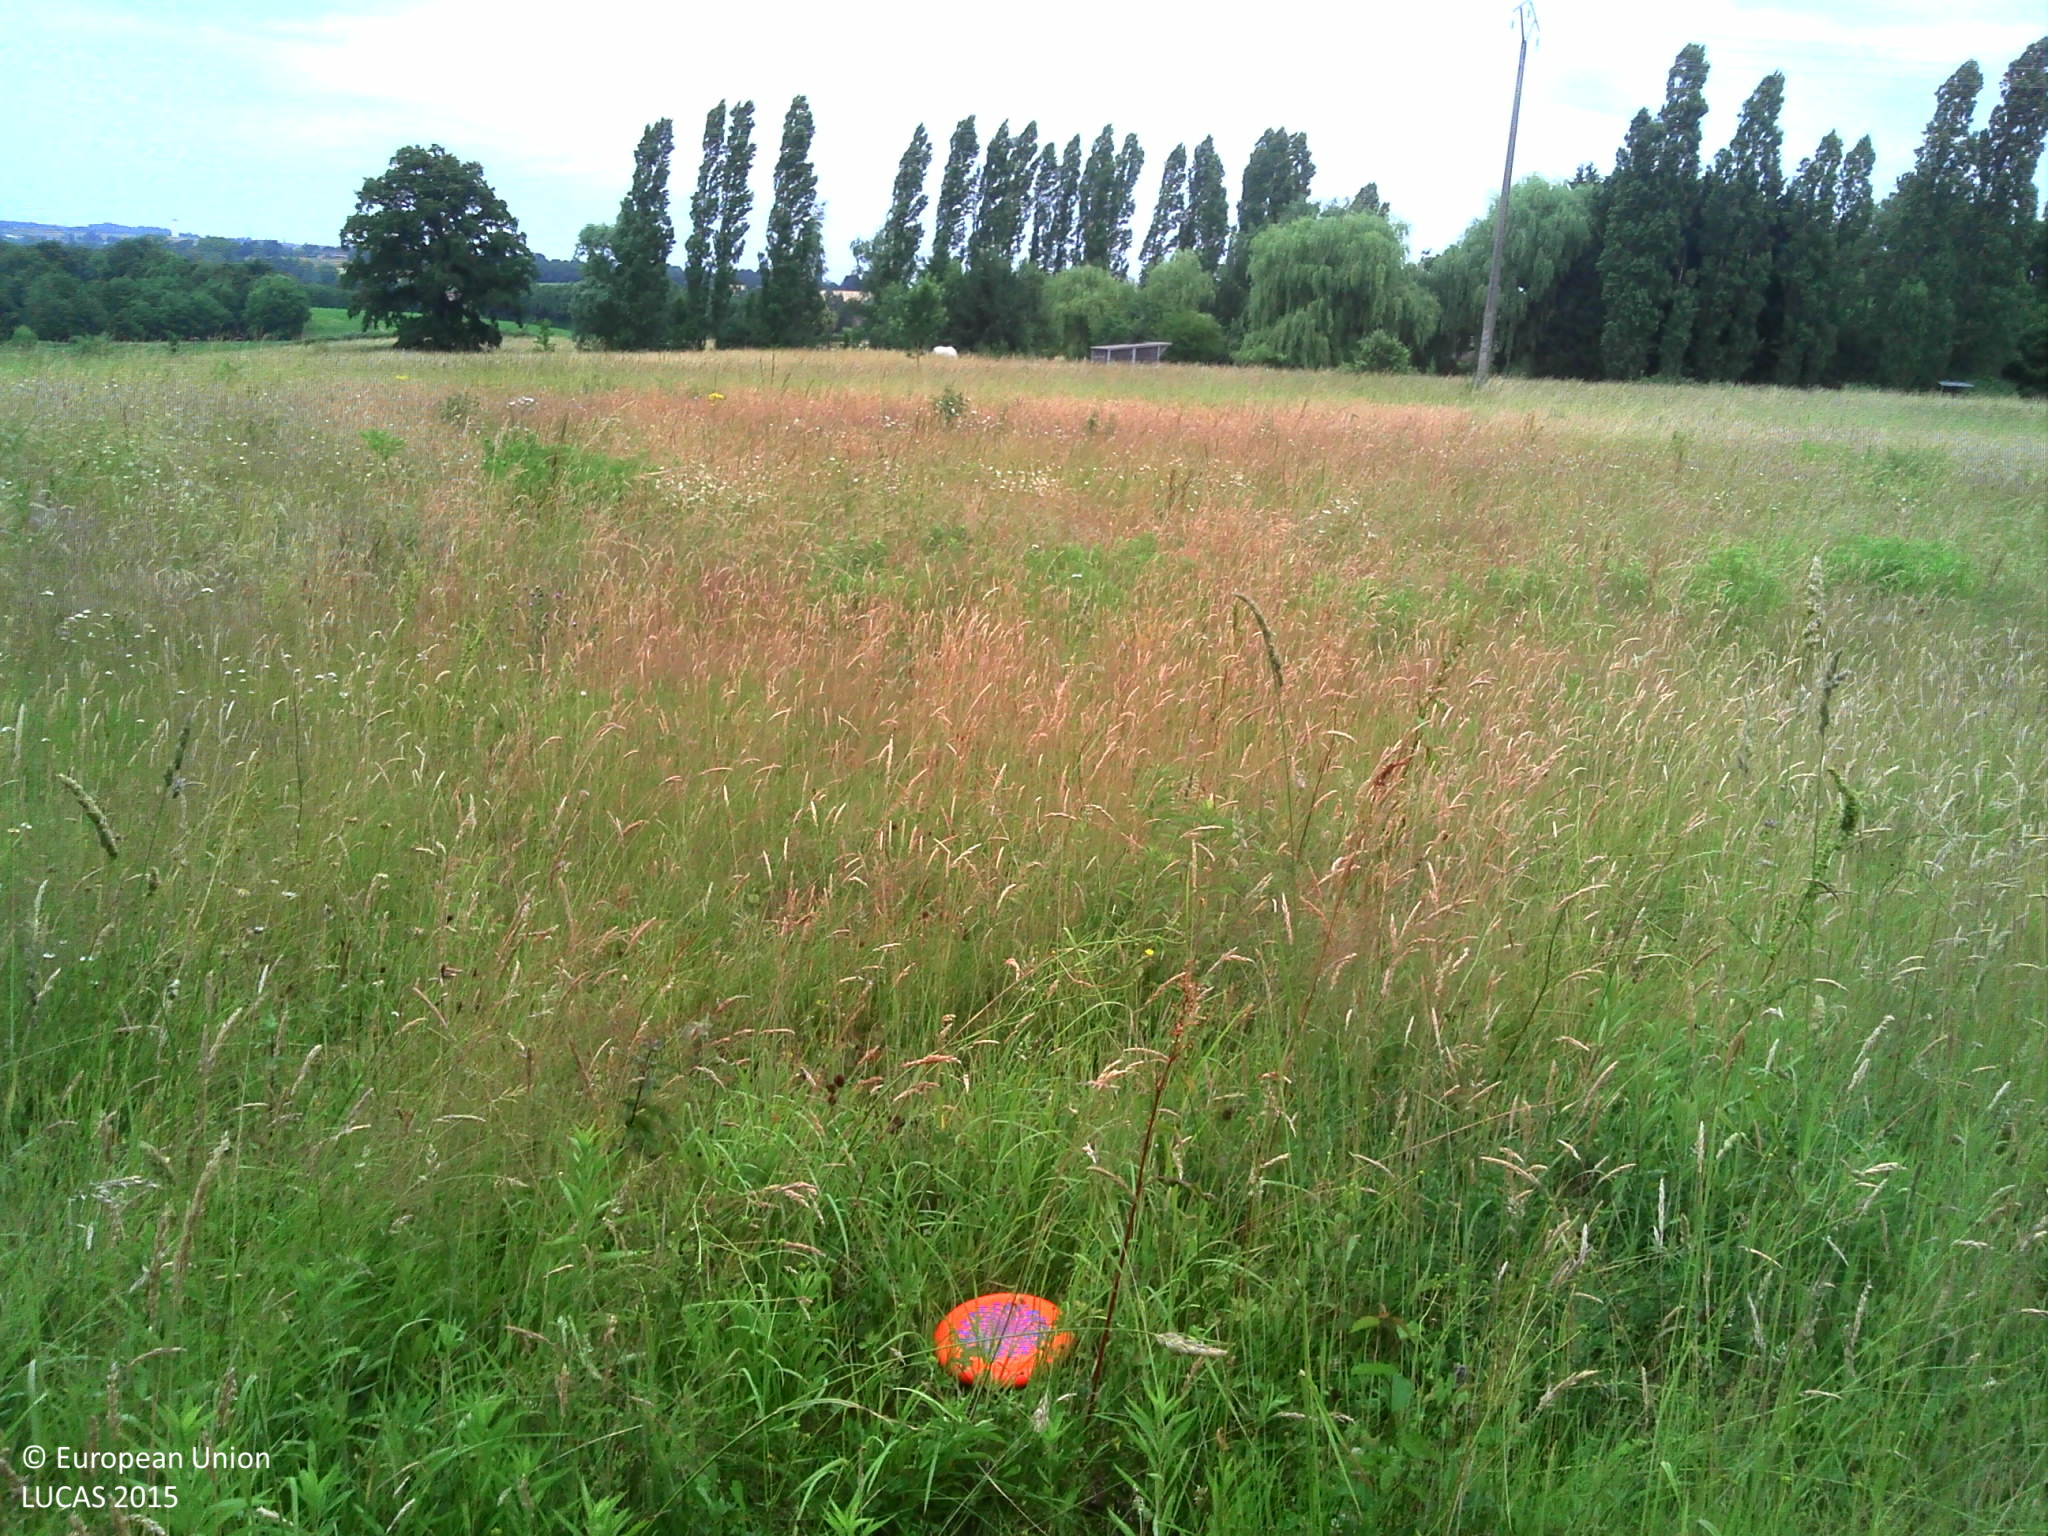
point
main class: Grassland
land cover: Grassland without tree/shrub cover
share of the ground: > 75 %
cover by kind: herbaceous plants 100 %
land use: Agriculture (excluding fallow land and kitchen gardens)
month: June
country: FR
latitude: 46.1029
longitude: 4.8929
